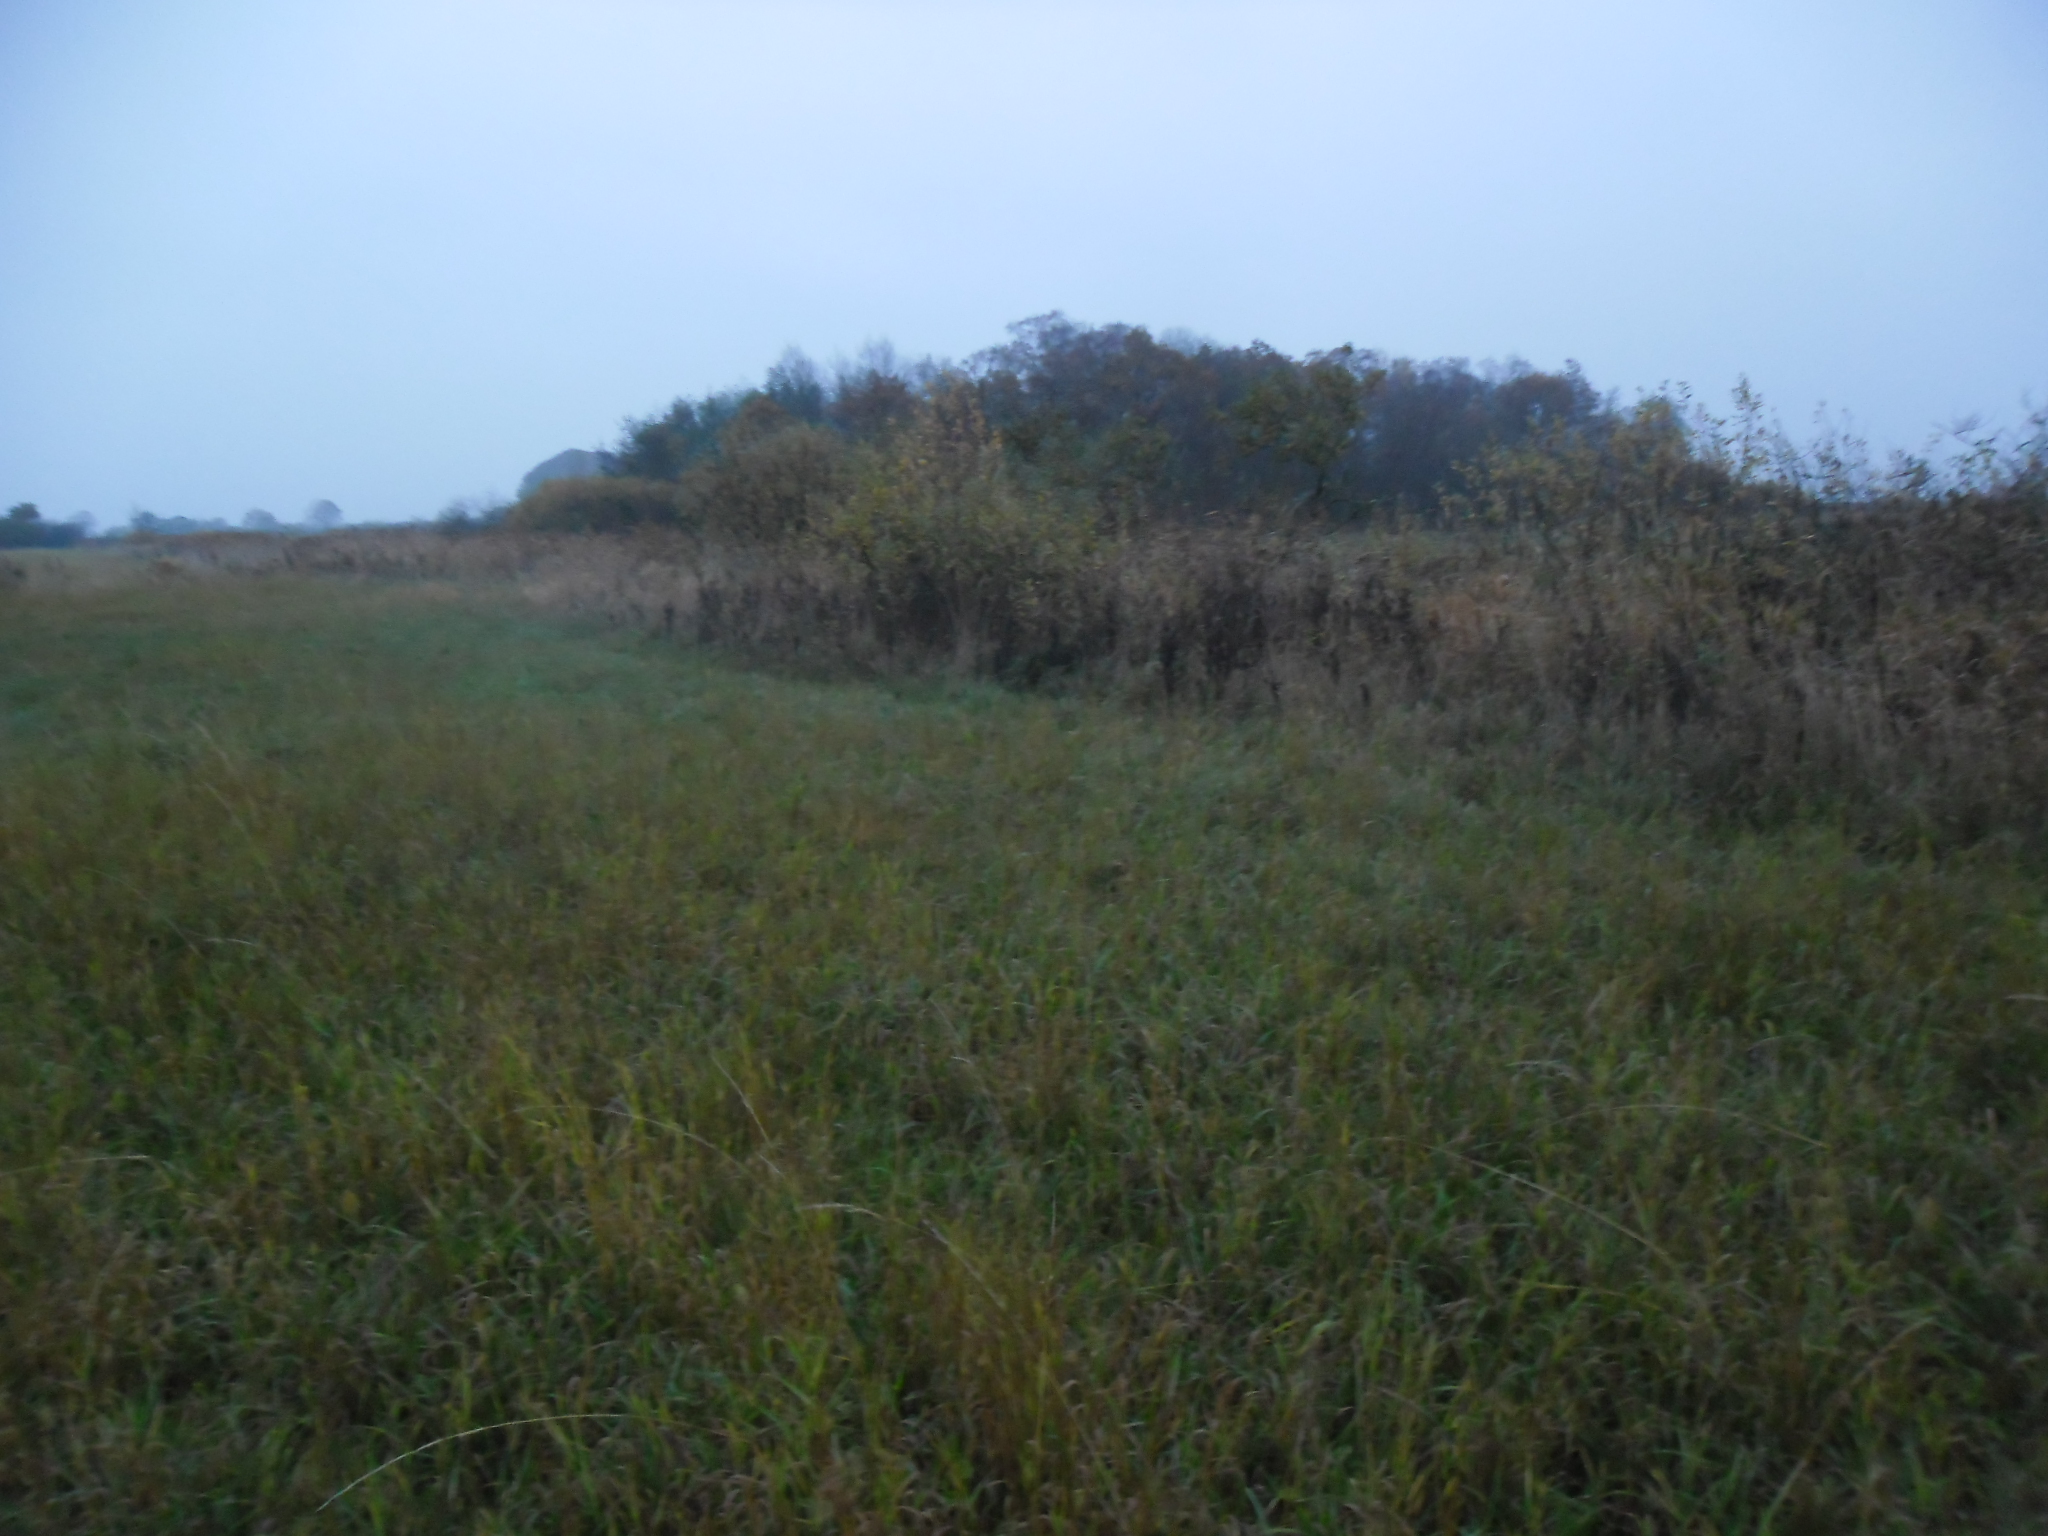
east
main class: Grassland
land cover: Grassland without tree/shrub cover
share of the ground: > 75 %
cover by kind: herbaceous plants 100 %
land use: Agriculture (excluding fallow land and kitchen gardens)
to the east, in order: Grassland without tree/shrub cover; Shruby margins; Ditches and canals; Fences; Grassland without tree/shrub cover; Fences; Broadleaved woodland; Ditches and canals; Broadleaved woodland
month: November
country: SE
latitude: 56.2129
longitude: 12.7223
